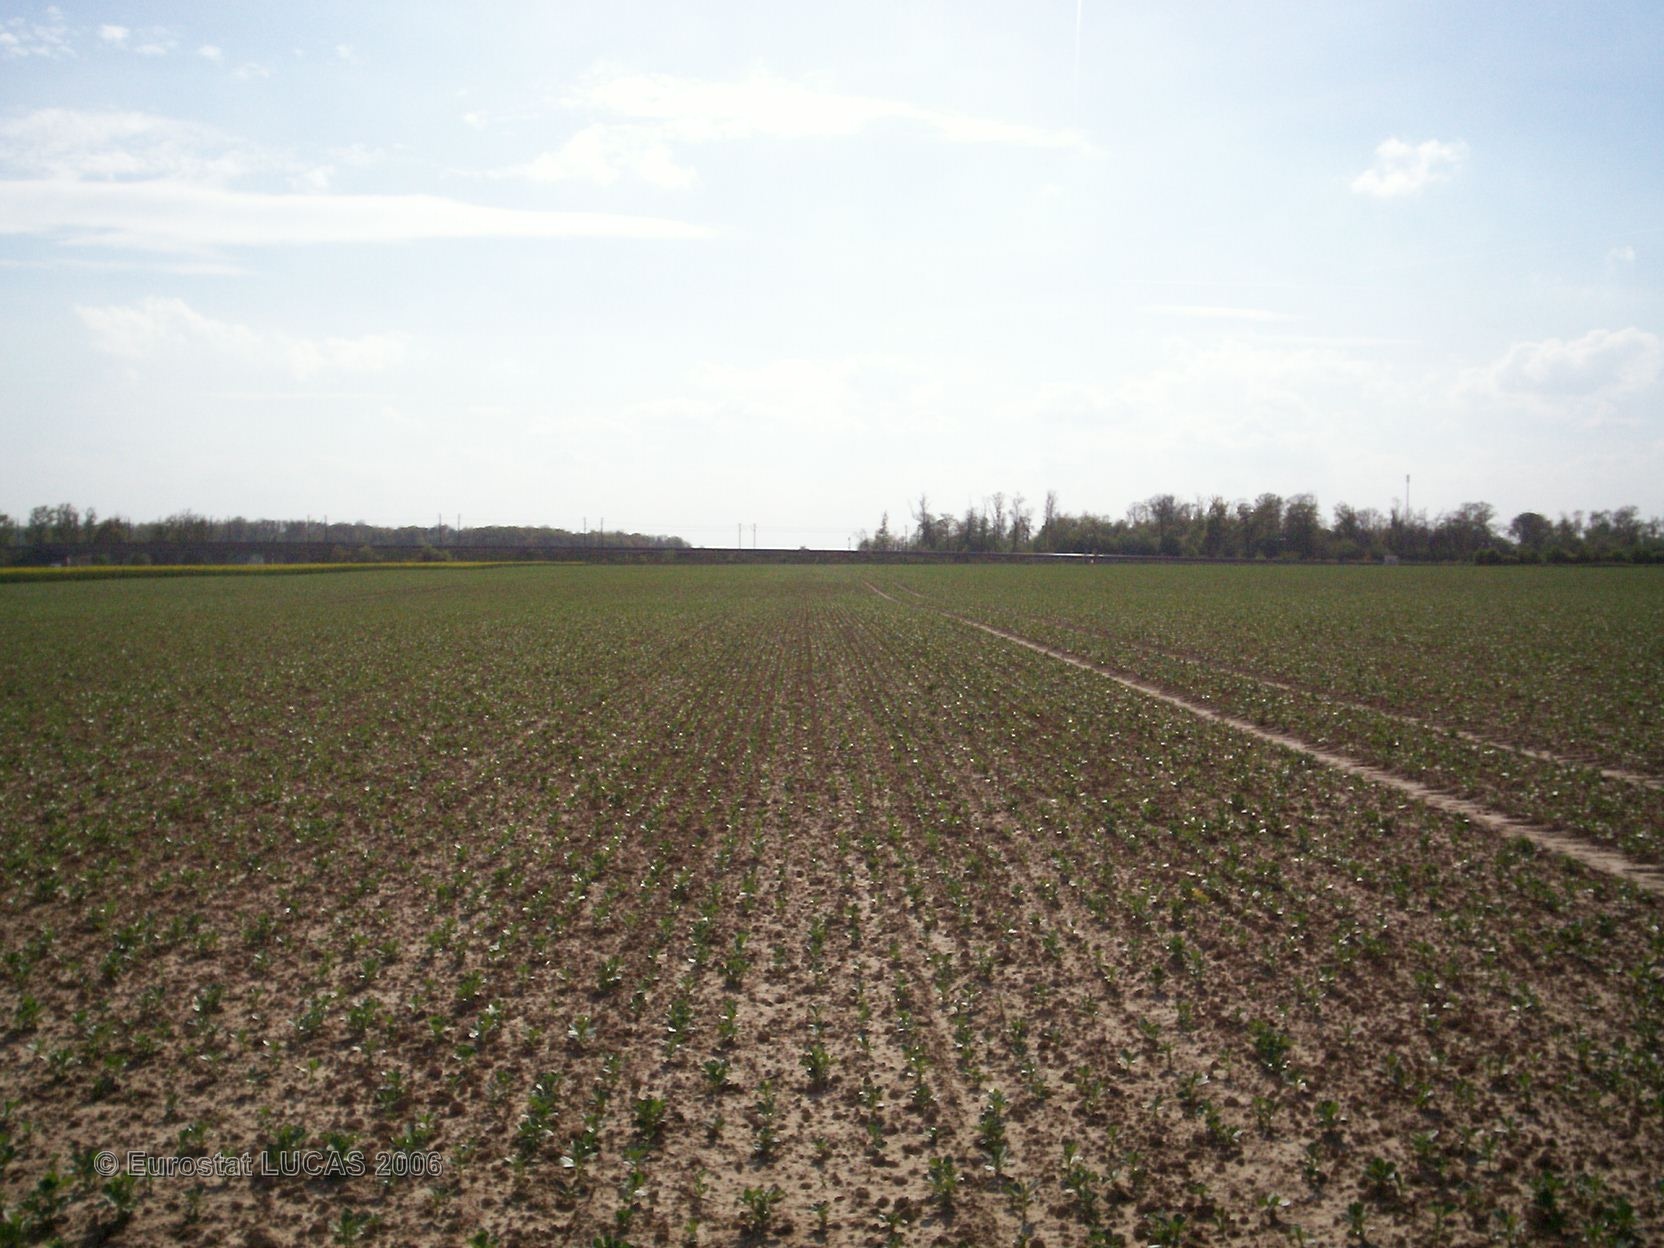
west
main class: Cropland
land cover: Sugar beet
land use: Agriculture (excluding fallow land and kitchen gardens)
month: May
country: FR
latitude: 48.8359
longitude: 2.7832
